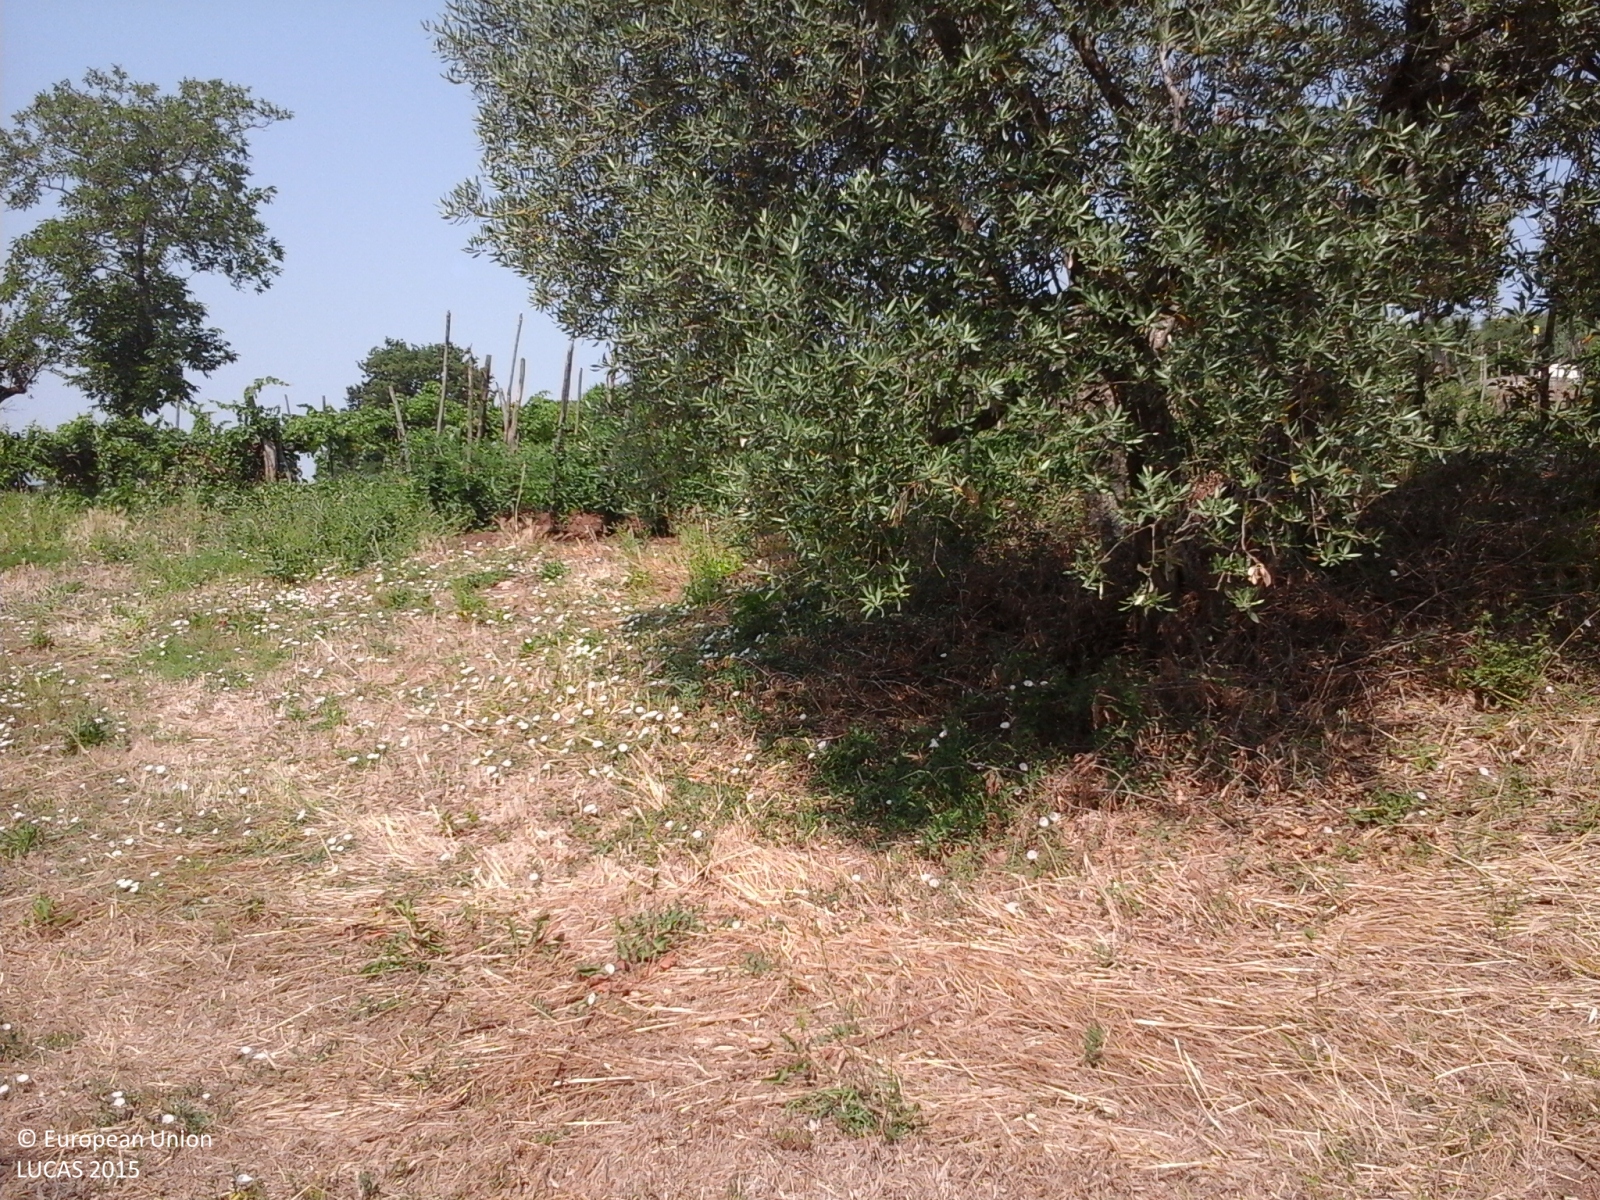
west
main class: Cropland
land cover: Olive groves
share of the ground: > 75 %
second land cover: Spontaneously vegetated surfaces
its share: > 75 %
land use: Agriculture (excluding fallow land and kitchen gardens)
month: July
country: IT
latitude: 40.9864
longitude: 15.1035
